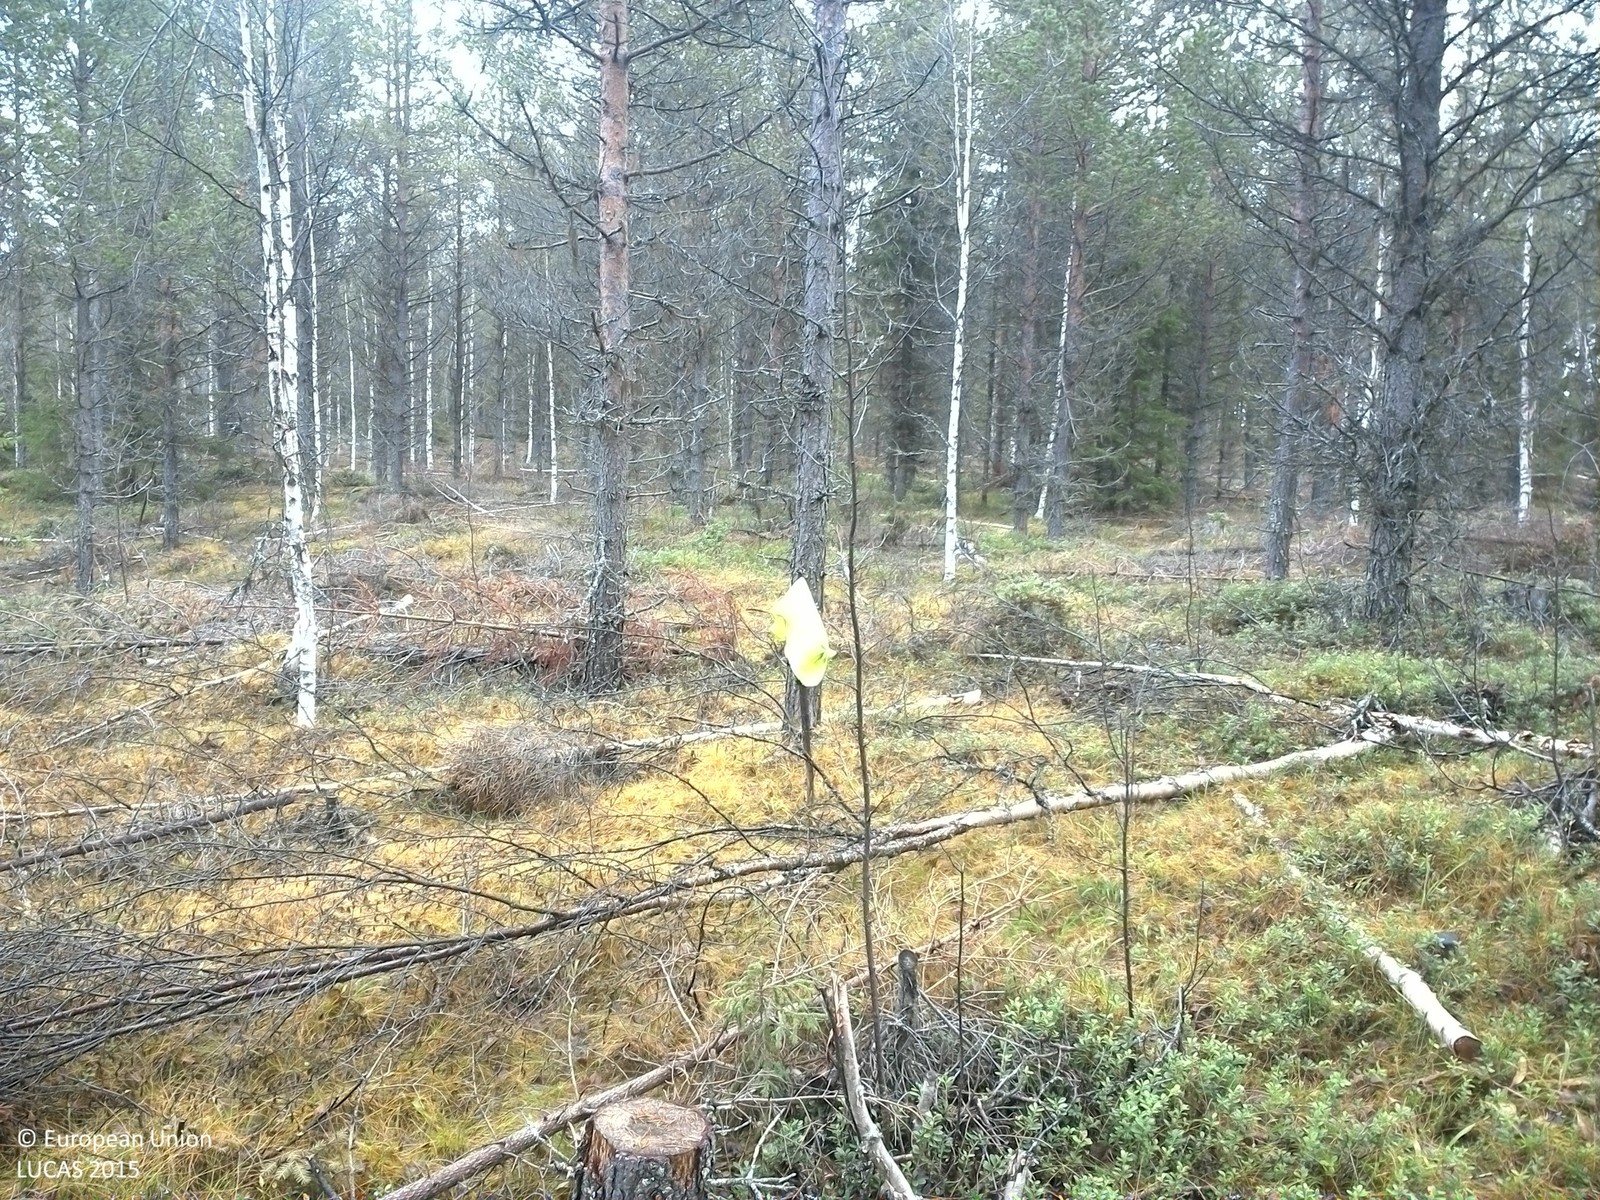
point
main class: Woodland
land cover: Pine dominated mixed woodland
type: boreal forest
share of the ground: 50 - 75 %
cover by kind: coniferous forest trees 35 %, shrubs 20 %, broadleaved forest trees 15 %, herbaceous plants 15 %, lichens and mosses 15 %
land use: Forestry
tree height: > 5 m
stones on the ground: 25 - 50 %
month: October
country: SE
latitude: 63.9144
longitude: 15.2124
